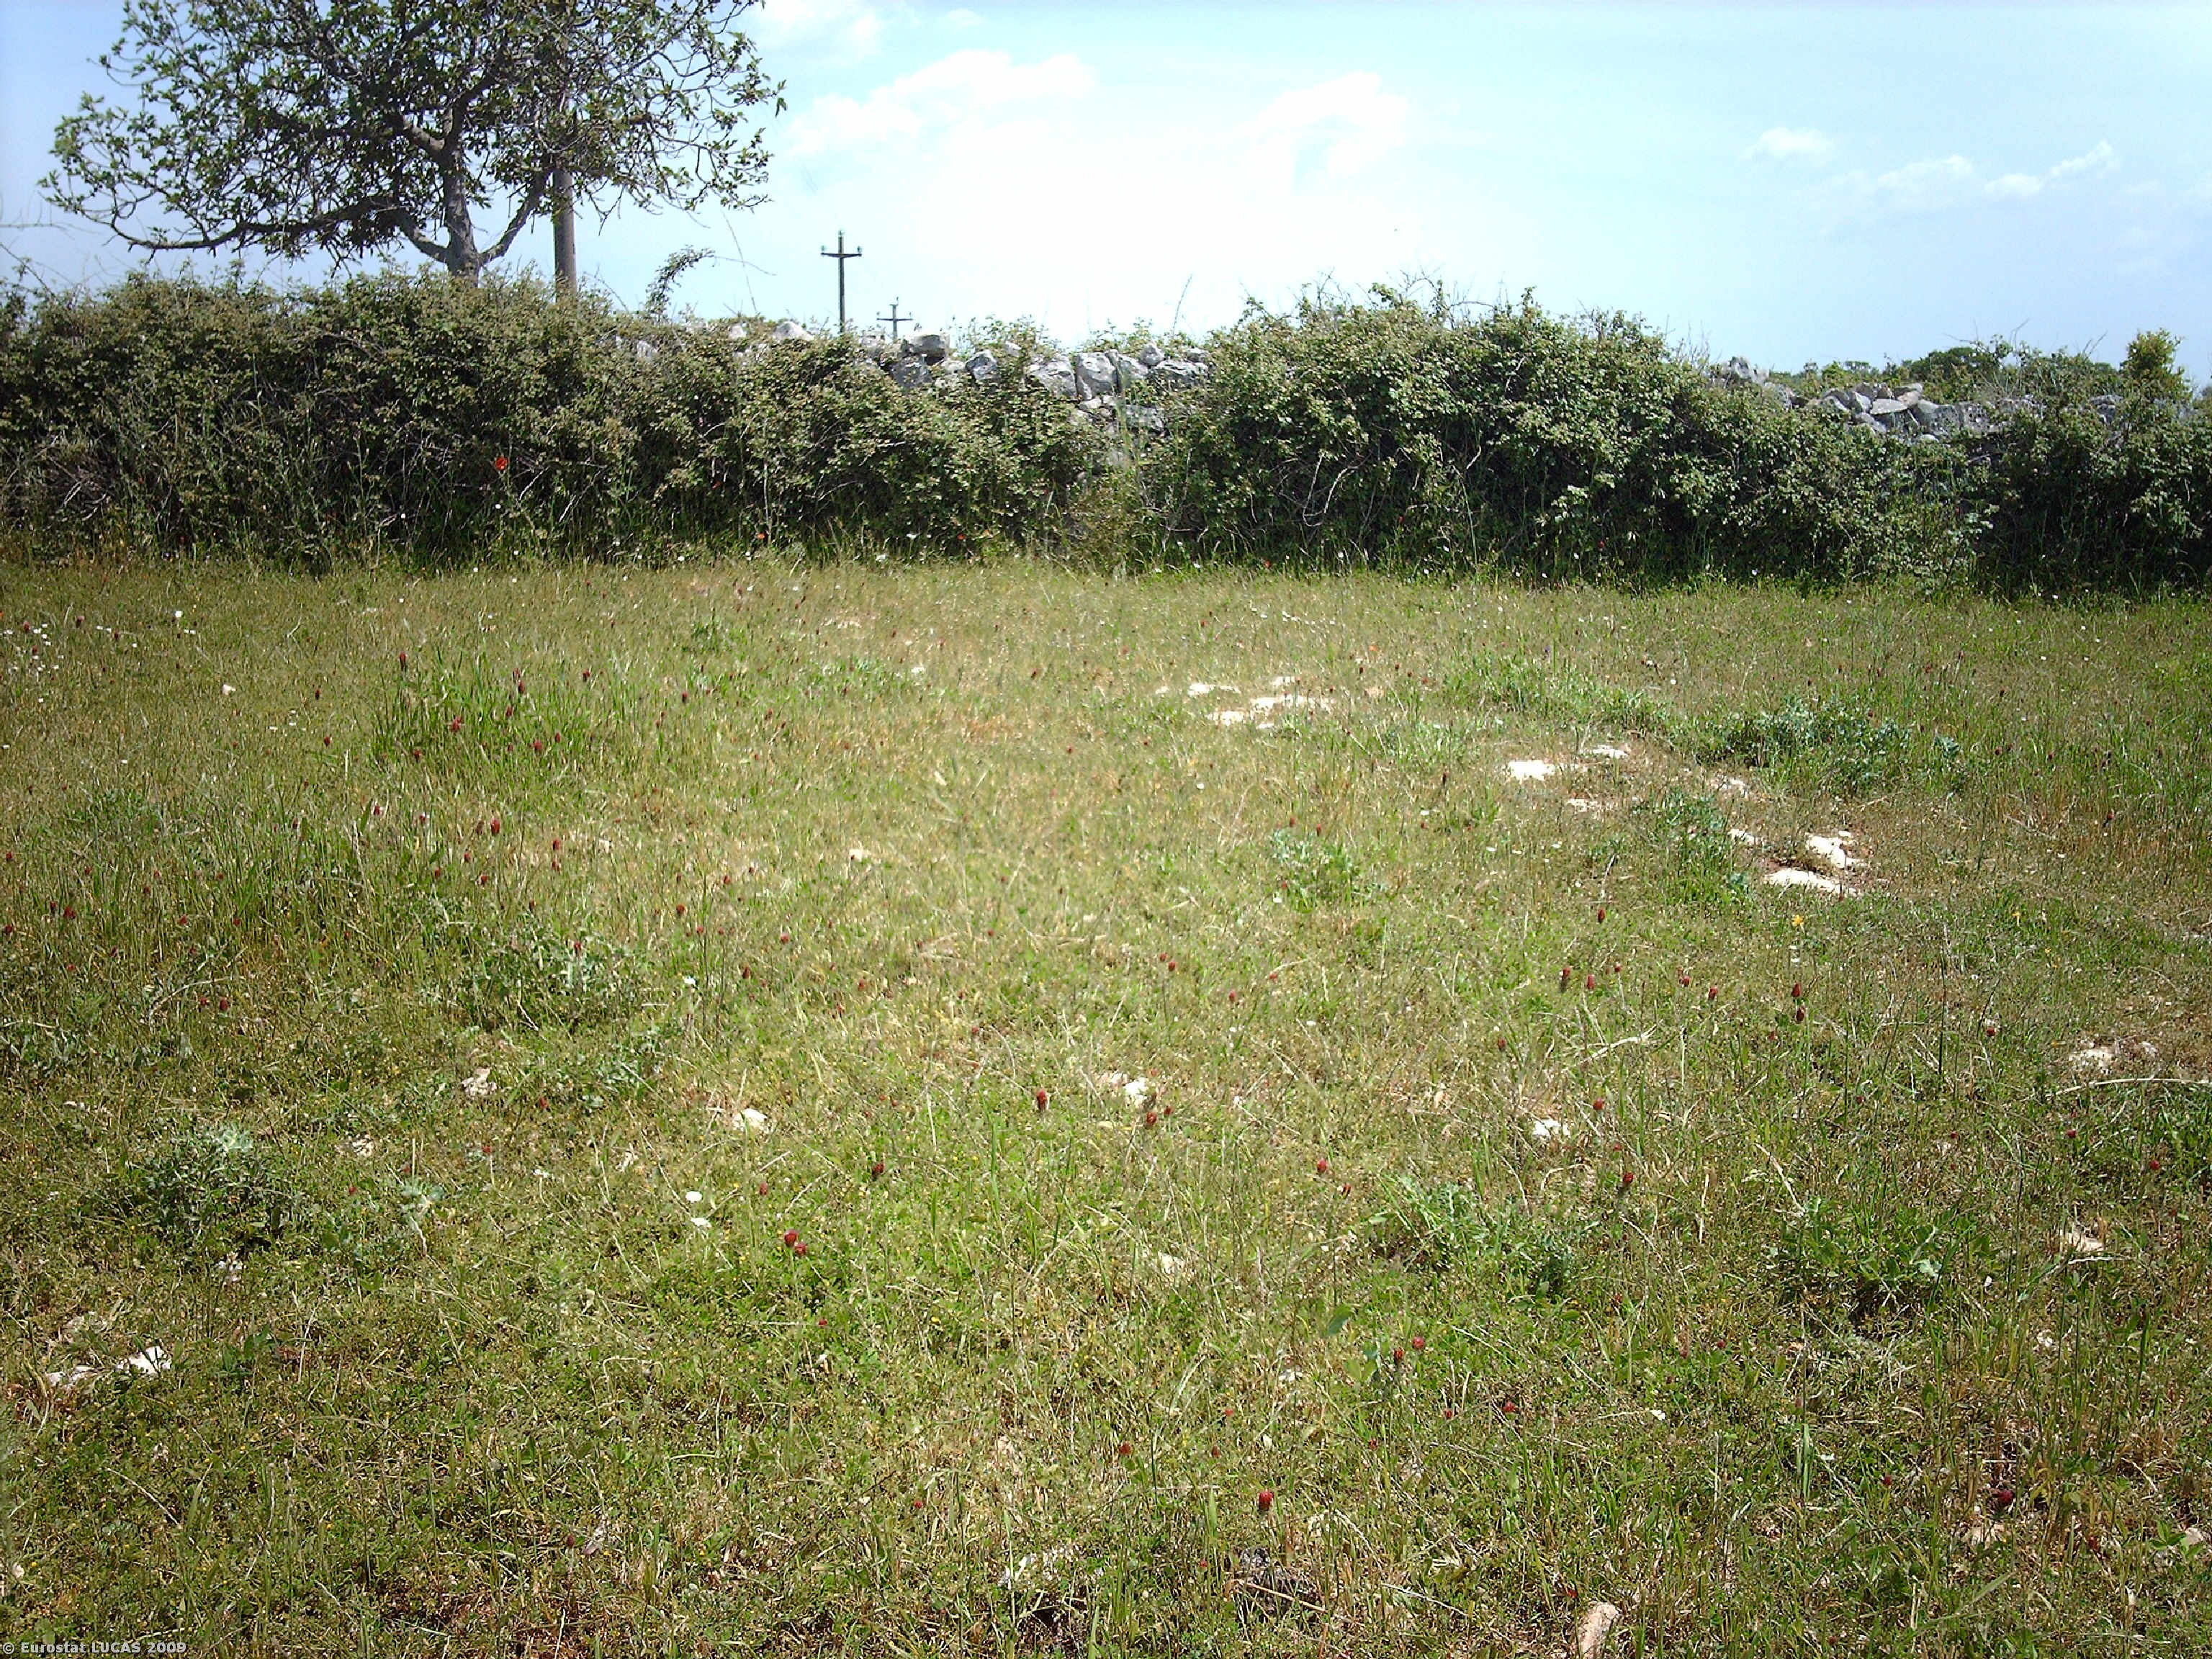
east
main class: Grassland
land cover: Grassland without tree/shrub cover
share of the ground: > 75 %
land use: Agriculture (excluding fallow land and kitchen gardens)
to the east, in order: Grassland without tree/shrub cover; Shruby margins; Dry stone walls; Tracks; Grass margins; Dry stone walls; Grass margins; Grassland without tree/shrub cover; Dry stone walls; Olive groves; Grassland without tree/shrub cover; Dry stone walls; Grass margins; Dry stone walls; Grassland with sparse tree/shrub cover
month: May
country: IT
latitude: 40.8316
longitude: 17.0335
